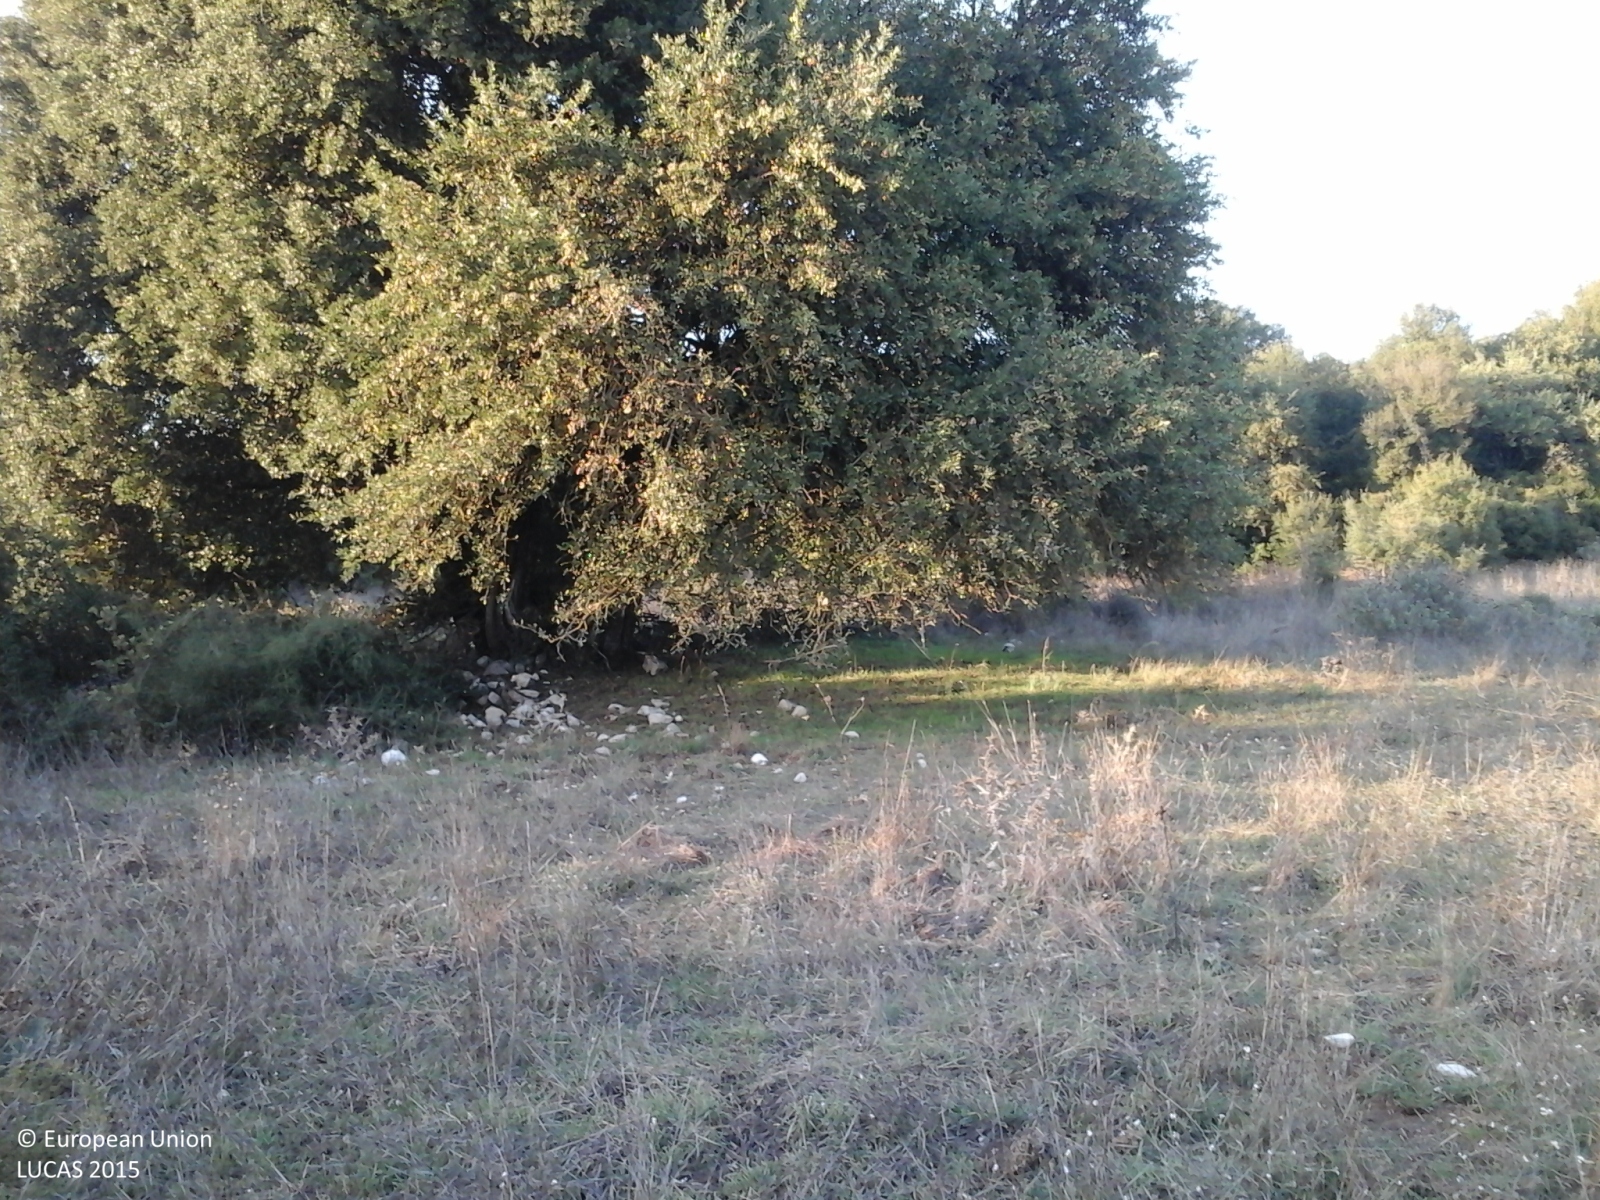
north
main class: Grassland
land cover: Grassland with sparse tree/shrub cover
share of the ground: > 75 %
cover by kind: herbaceous plants 80 %, shrubs 10 %, broadleaved forest trees 5 %, unconsolidated bare surface 5 %
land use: Semi-natural and natural areas not in use
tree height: > 5 m
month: September
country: GR
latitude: 39.8321
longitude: 20.6472
